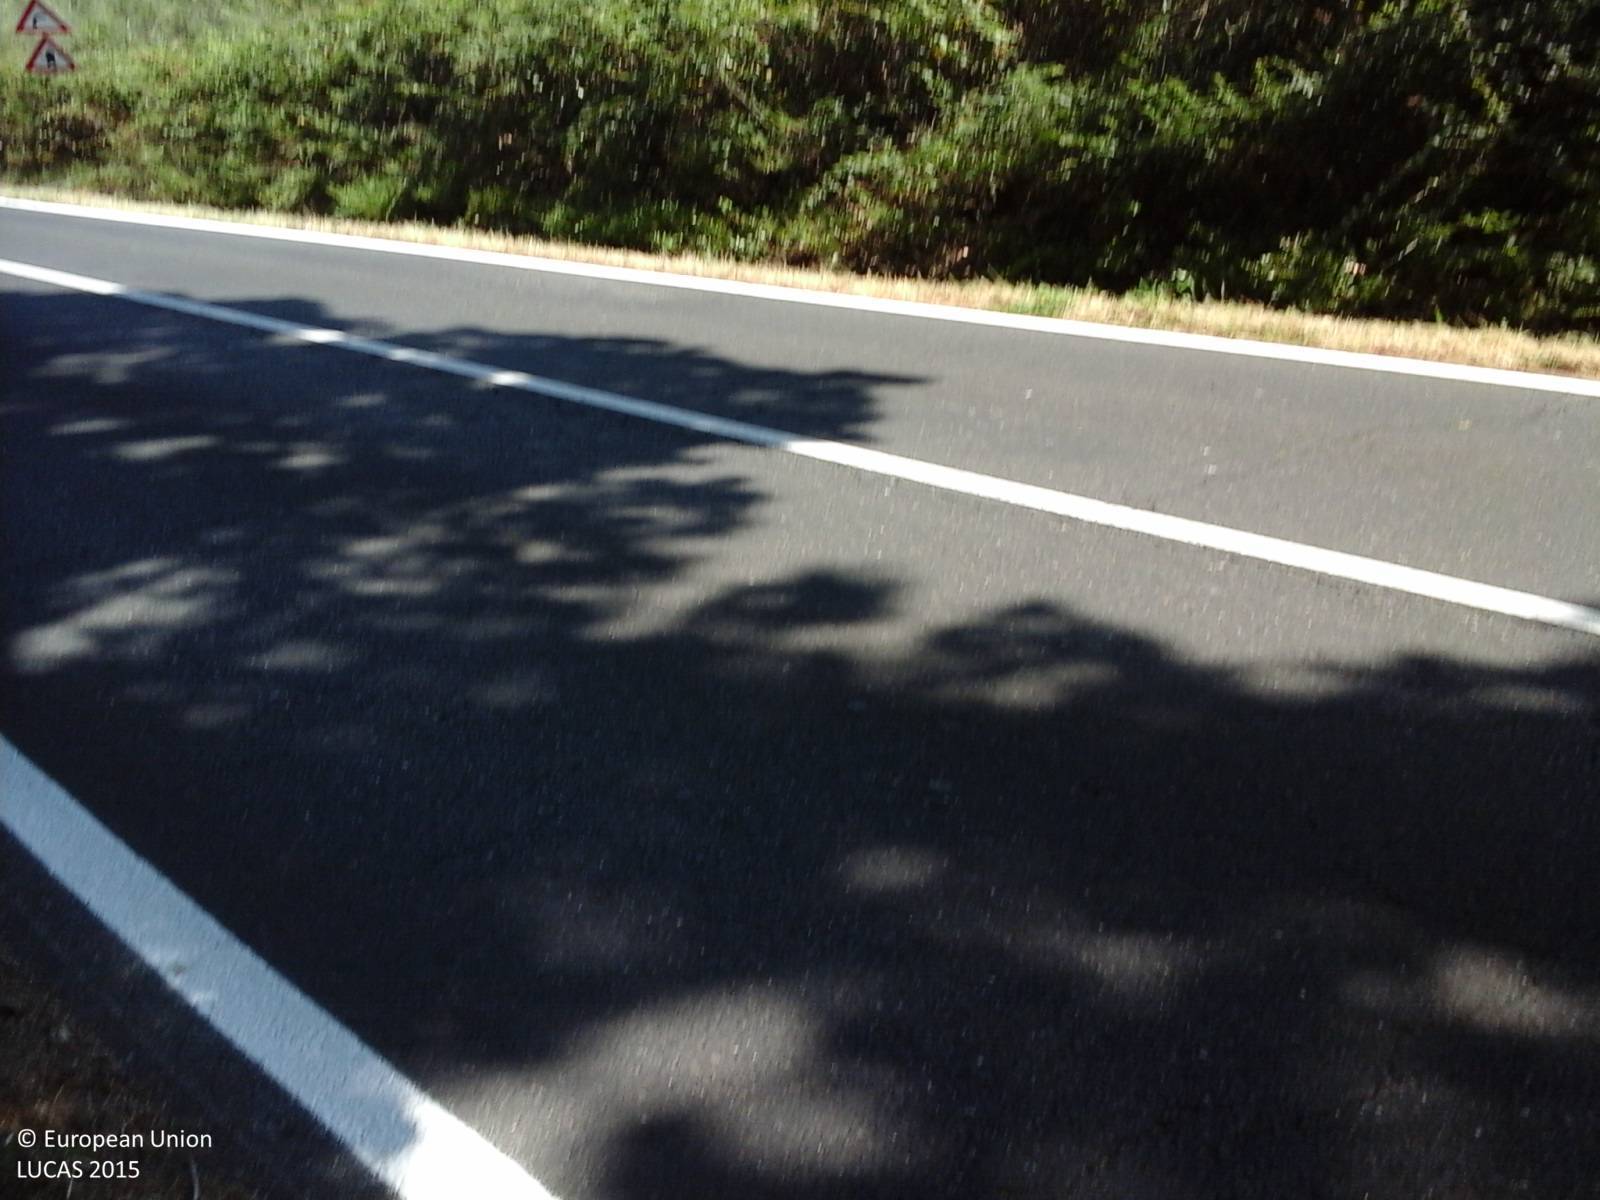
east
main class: Cropland
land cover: Olive groves
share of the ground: > 75 %
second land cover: Spontaneously vegetated surfaces
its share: > 75 %
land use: Agriculture (excluding fallow land and kitchen gardens)
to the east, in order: Olive groves; Spontaneously vegetated surfaces; Tracks; Olive groves; Single bushes/trees; Fences; Electric lines; Paved roads, cycling and walking lanes; Grass margins; Fences; Abandoned hedges; Olive groves
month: August
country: IT
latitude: 42.1602
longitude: 12.2070
